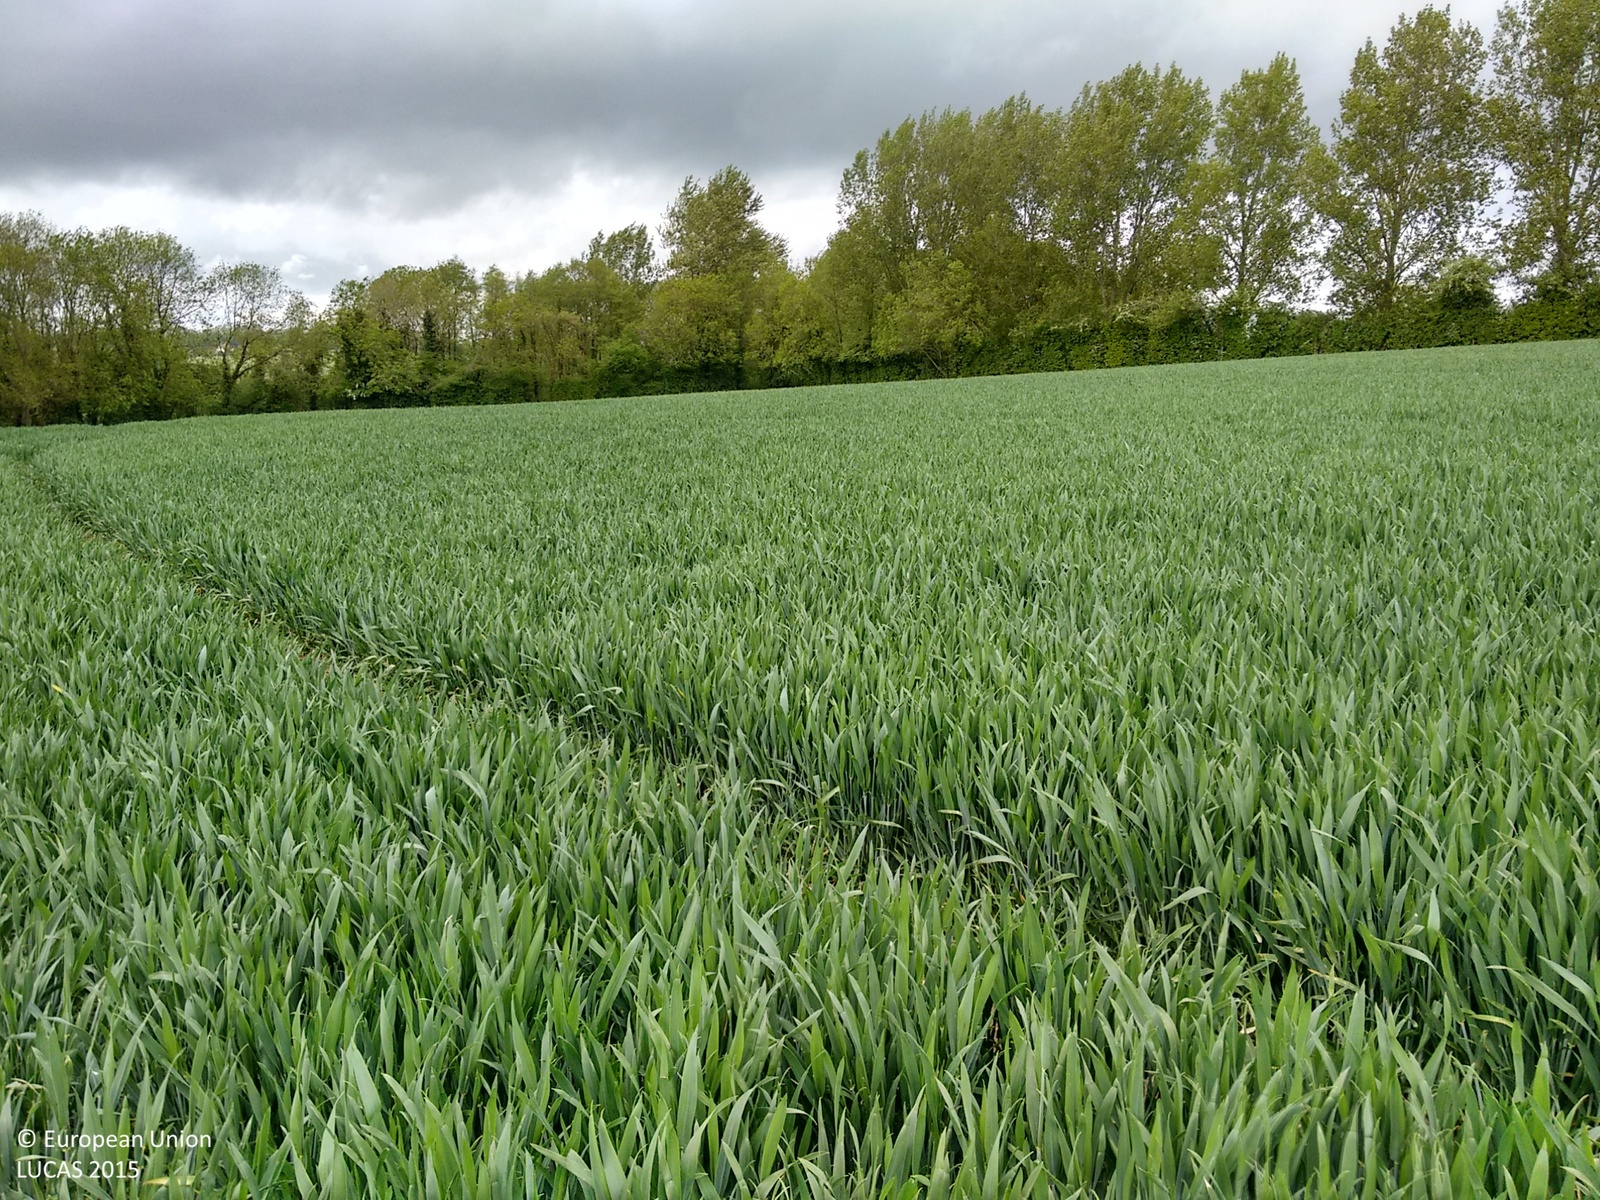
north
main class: Cropland
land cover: Common wheat
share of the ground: > 75 %
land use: Agriculture (excluding fallow land and kitchen gardens)
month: May
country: GB
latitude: 51.1984
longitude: 0.7149
